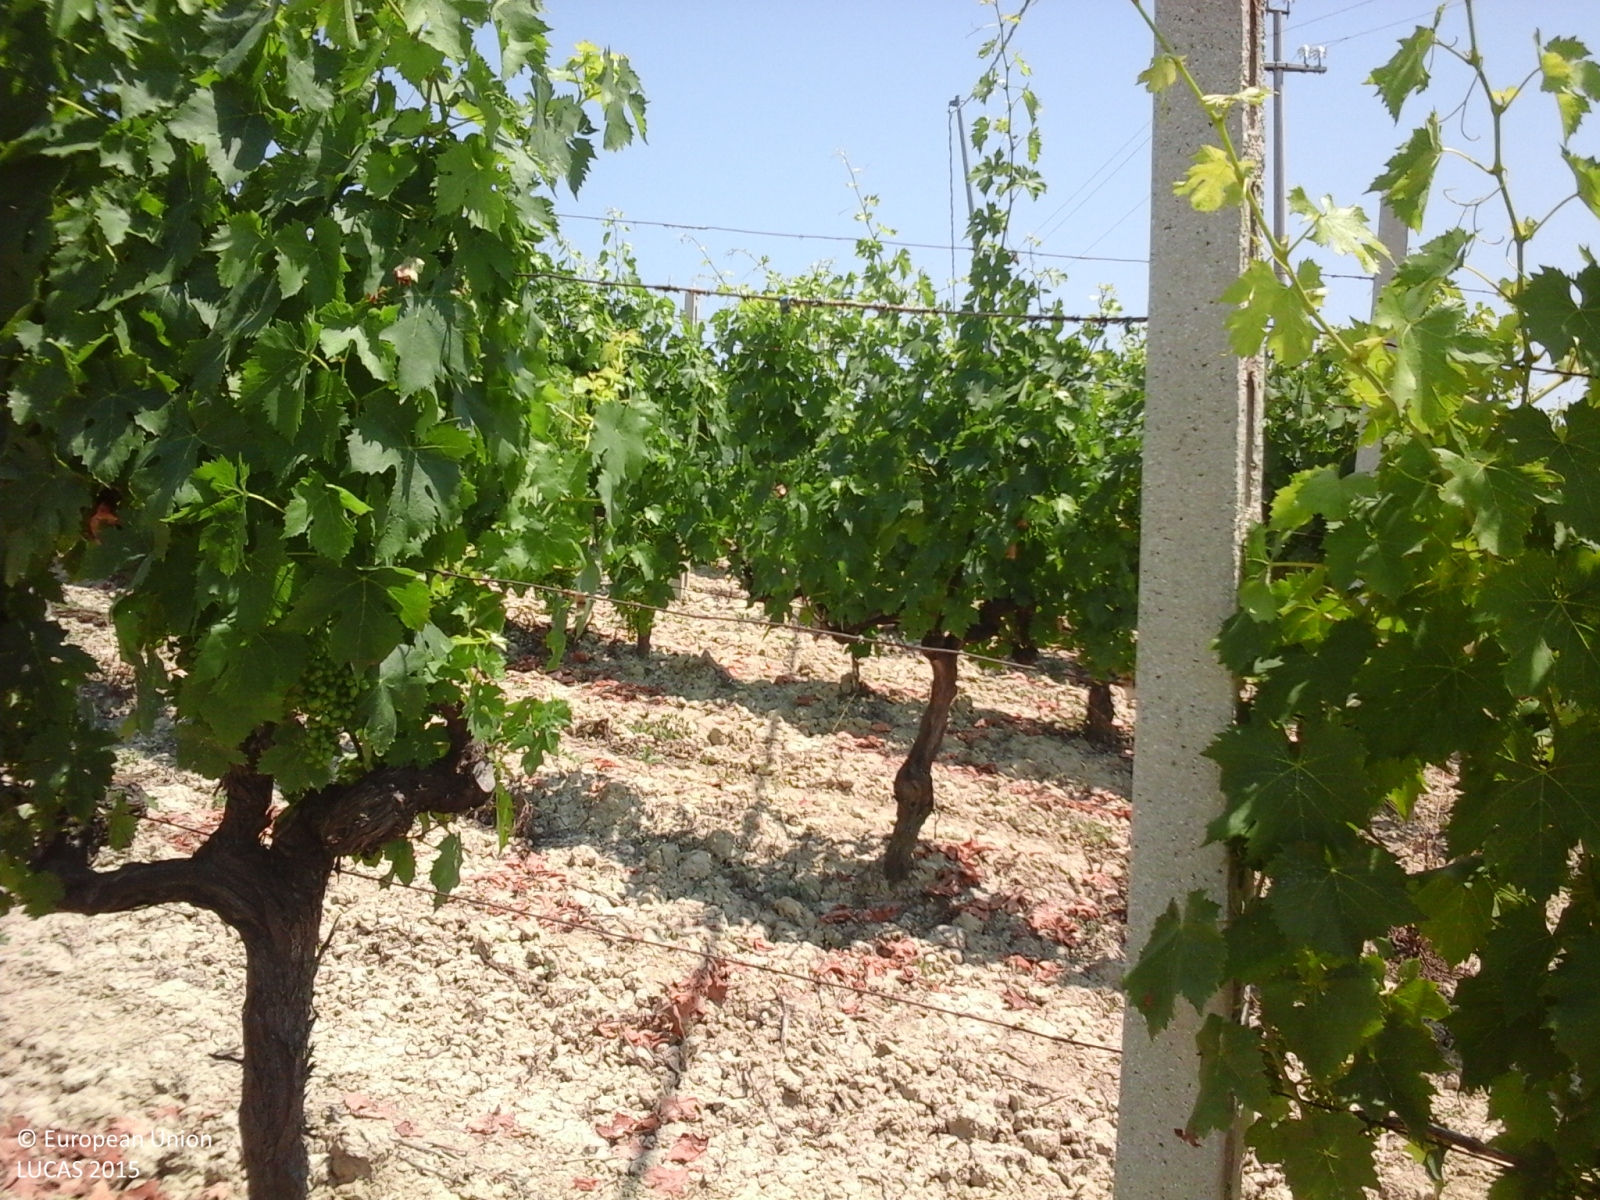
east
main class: Cropland
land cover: Vineyards
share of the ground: 50 - 75 %
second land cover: Other bare soil
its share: > 75 %
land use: Agriculture (excluding fallow land and kitchen gardens)
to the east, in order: Vineyards; Other bare soil; Electric lines; Vineyards; Spontaneously vegetated surfaces; Electric lines; Lines of trees; Tracks; Lines of trees; Spontaneously vegetated surfaces; Vineyards
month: June
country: IT
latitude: 42.9271
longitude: 13.7756
